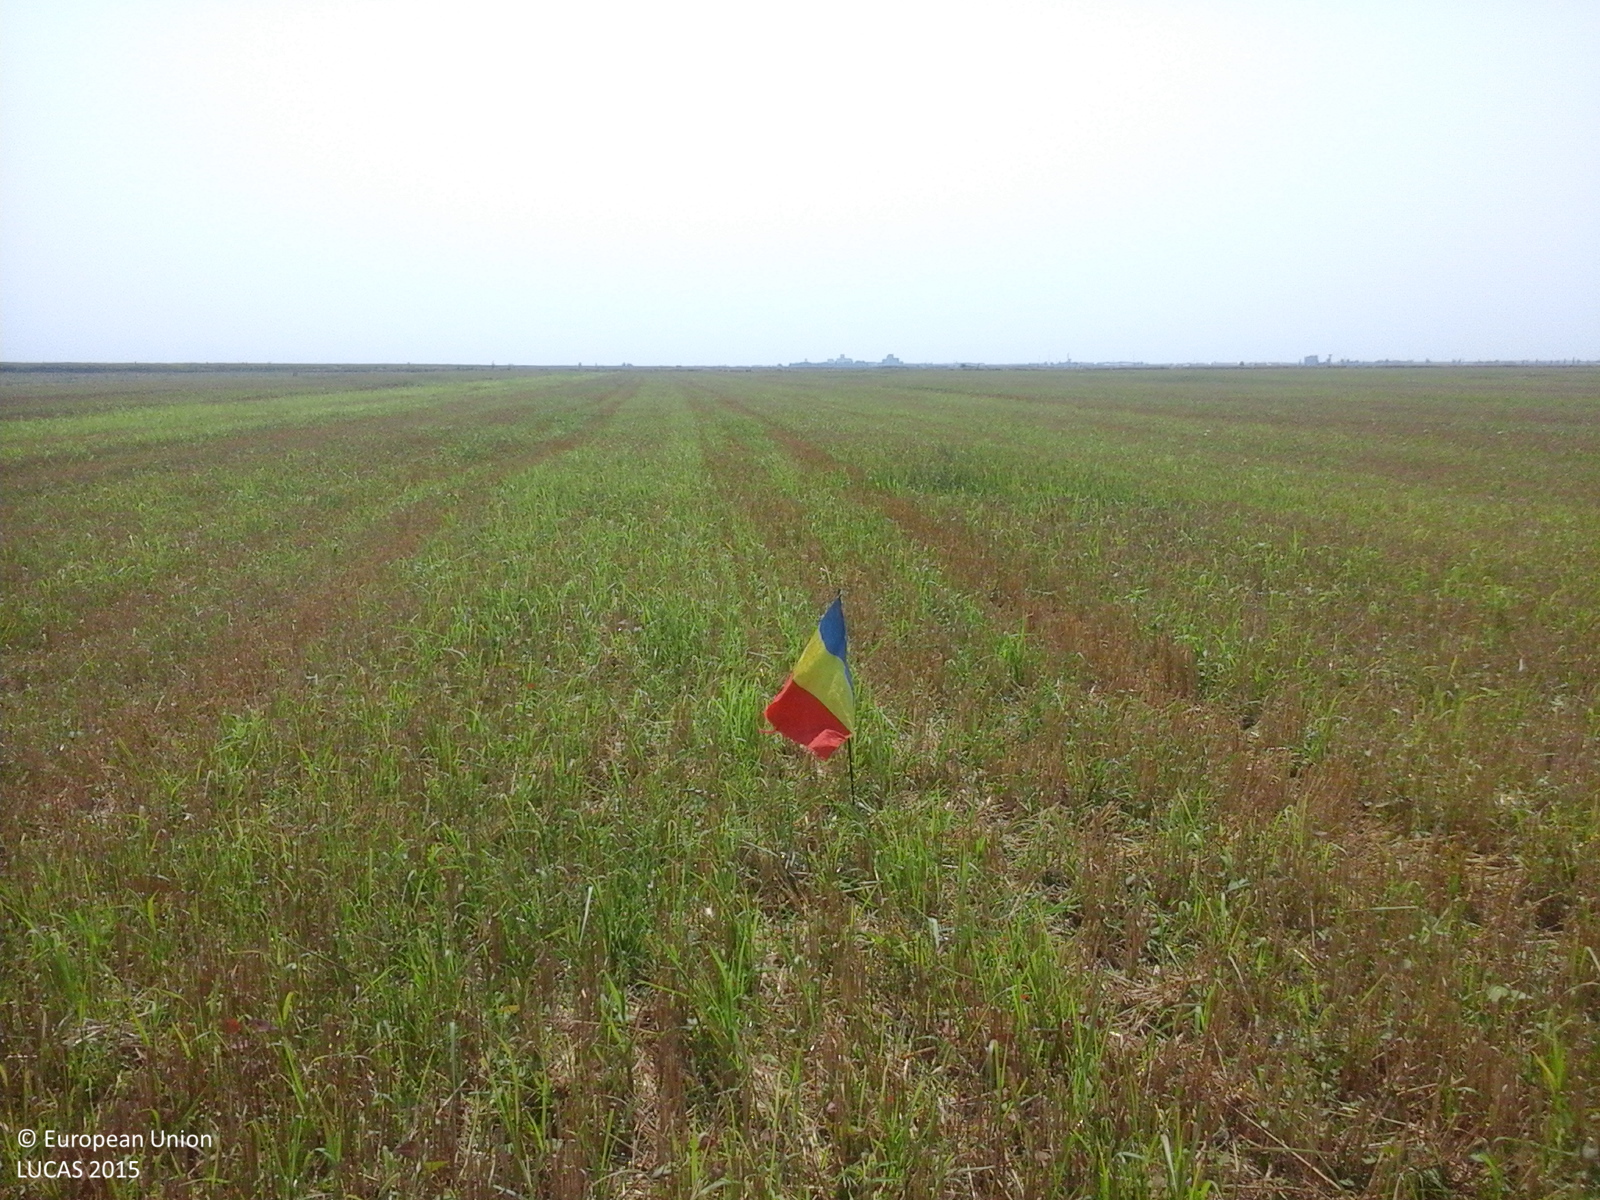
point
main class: Cropland
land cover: Common wheat
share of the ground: 50 - 75 %
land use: Agriculture (excluding fallow land and kitchen gardens)
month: July
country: RO
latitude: 44.7653
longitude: 26.6091
